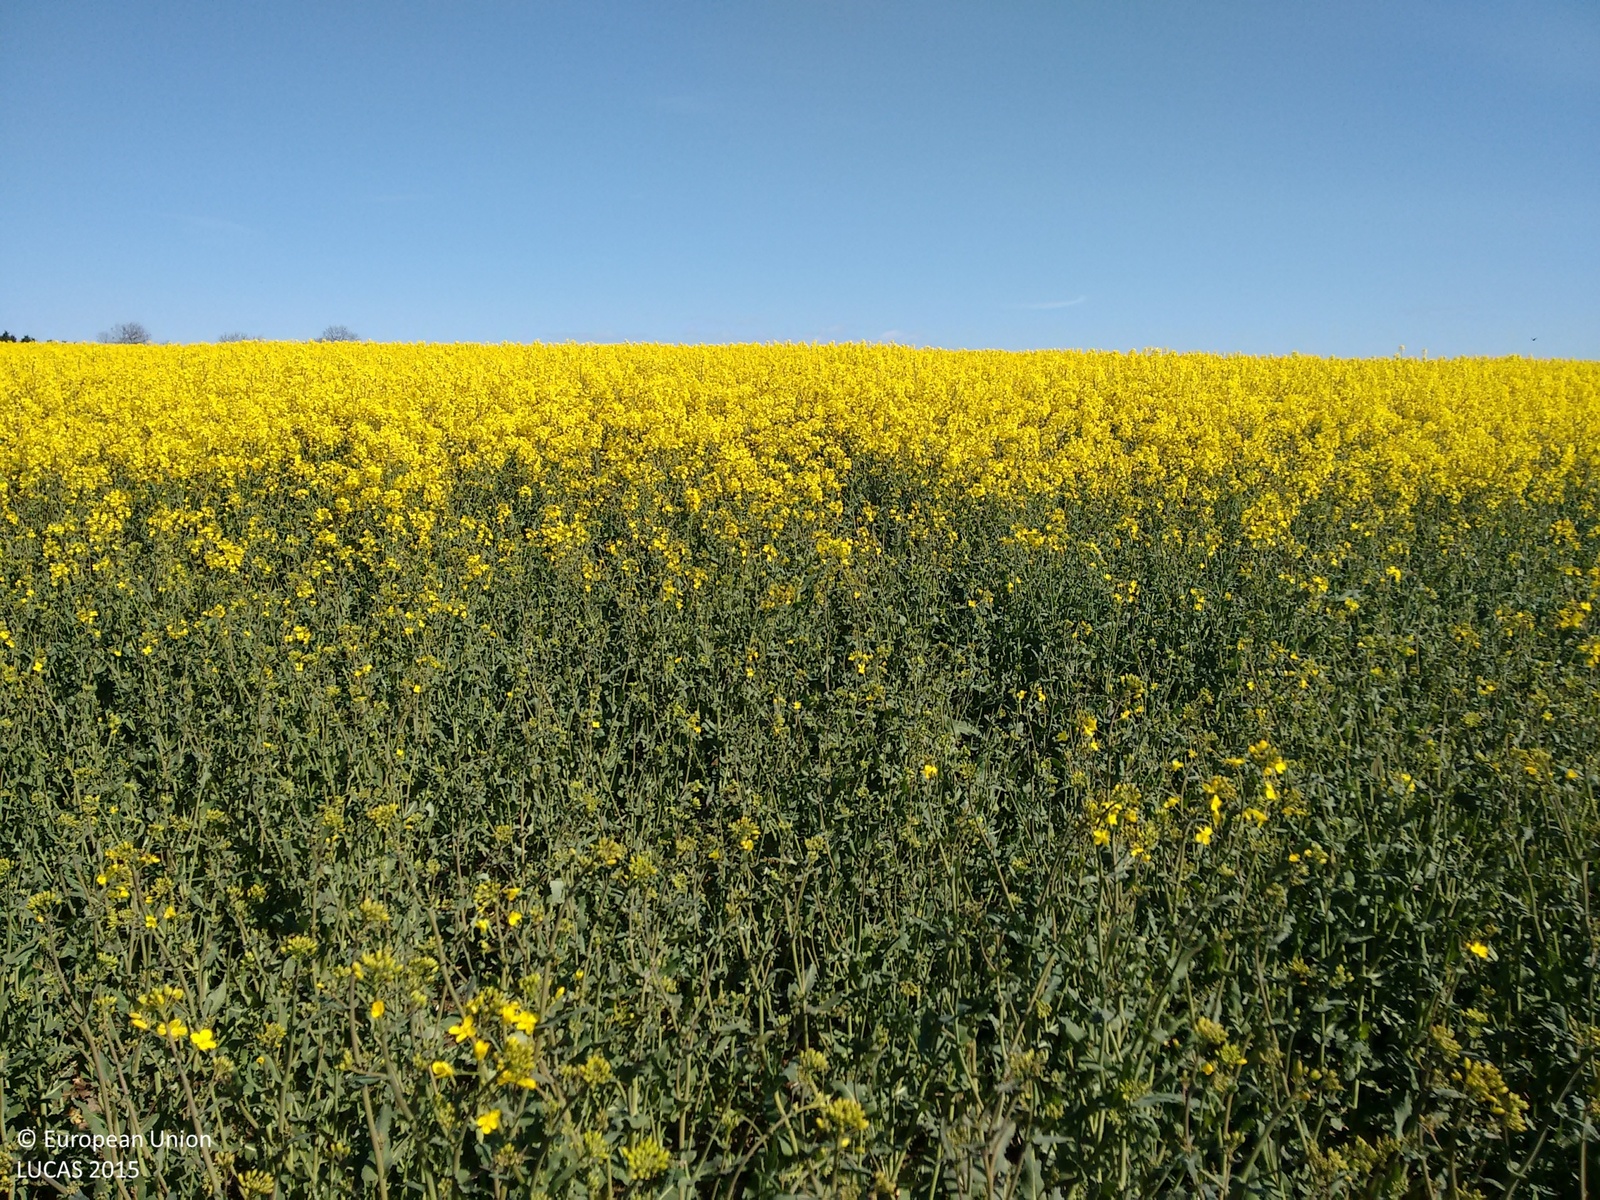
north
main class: Cropland
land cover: Rape and turnip rape
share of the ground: > 75 %
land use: Agriculture (excluding fallow land and kitchen gardens)
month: May
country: GB
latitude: 55.2320
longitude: -1.7009
